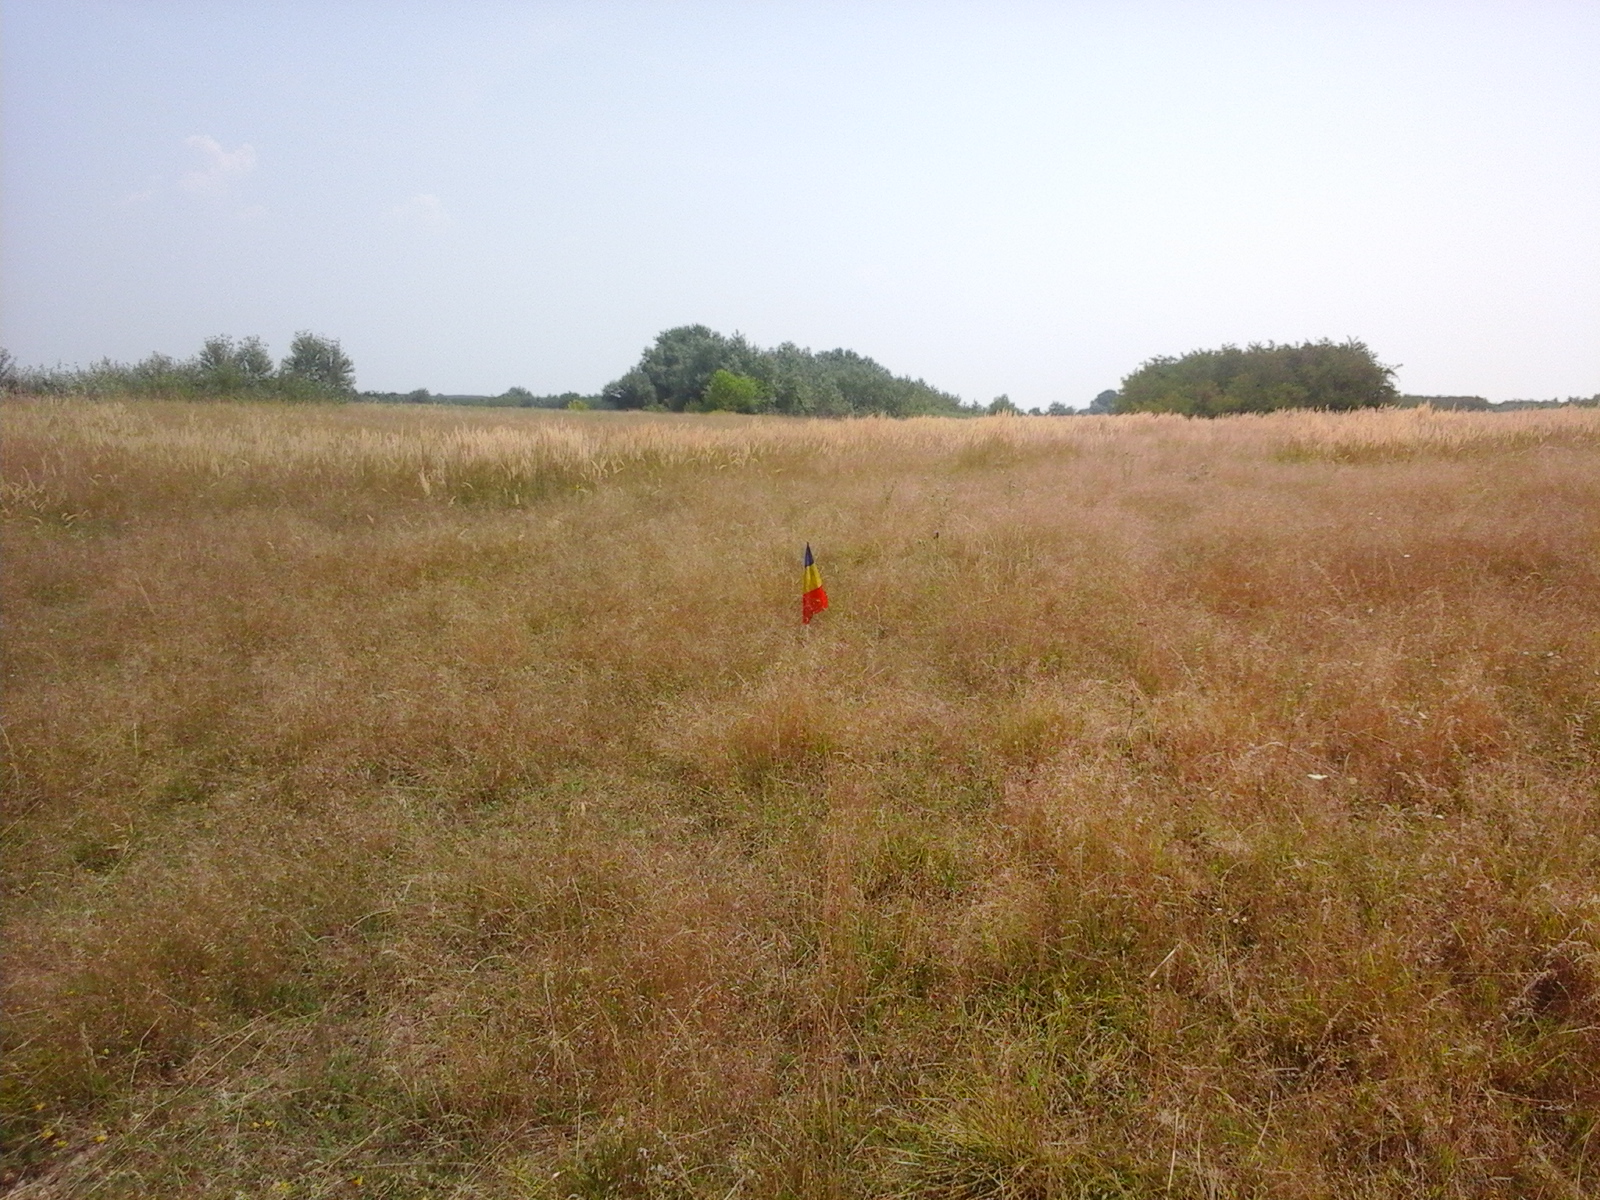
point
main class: Grassland
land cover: Grassland without tree/shrub cover
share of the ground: > 75 %
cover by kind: herbaceous plants 100 %
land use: Agriculture (excluding fallow land and kitchen gardens)
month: August
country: RO
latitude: 44.3604
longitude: 22.6237
